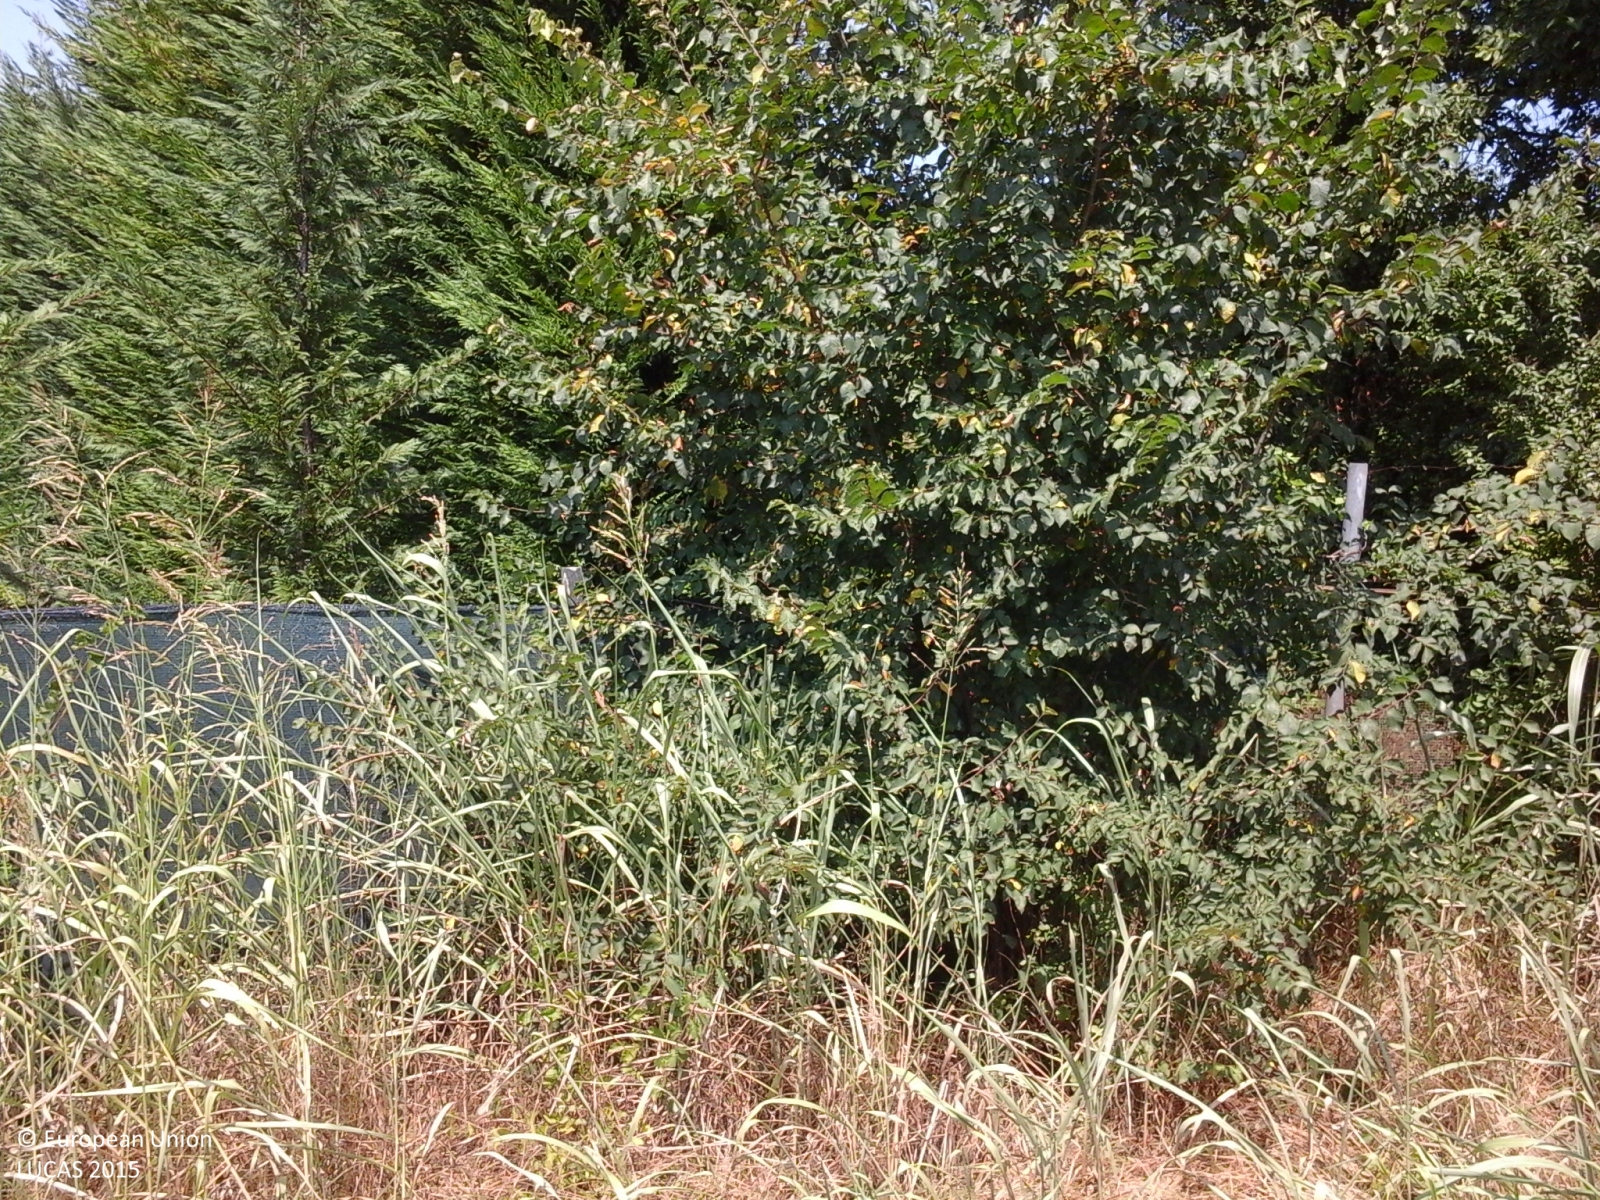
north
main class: Grassland
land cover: Grassland without tree/shrub cover
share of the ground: > 75 %
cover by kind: herbaceous plants 100 %
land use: Agriculture (excluding fallow land and kitchen gardens)
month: July
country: IT
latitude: 45.7318
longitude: 12.2969
